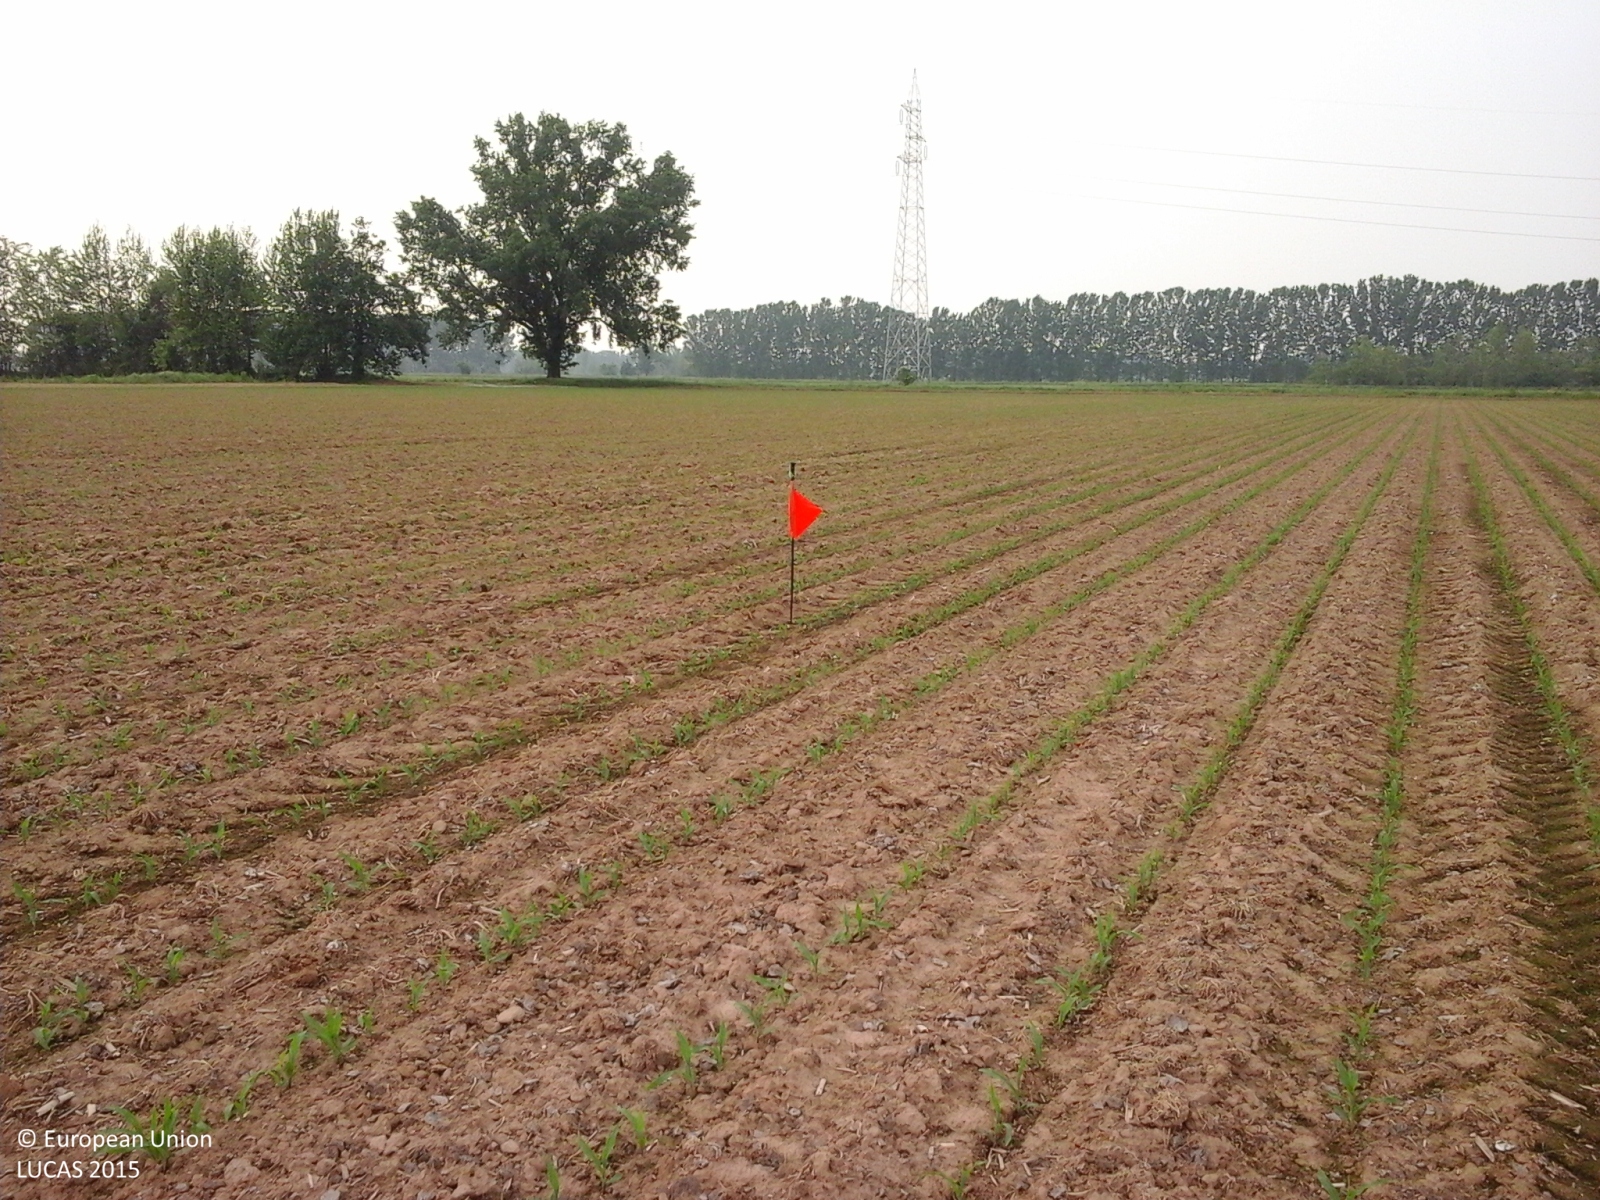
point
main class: Cropland
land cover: Maize
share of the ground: < 10 %
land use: Agriculture (excluding fallow land and kitchen gardens)
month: May
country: IT
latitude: 45.2340
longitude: 9.8601
